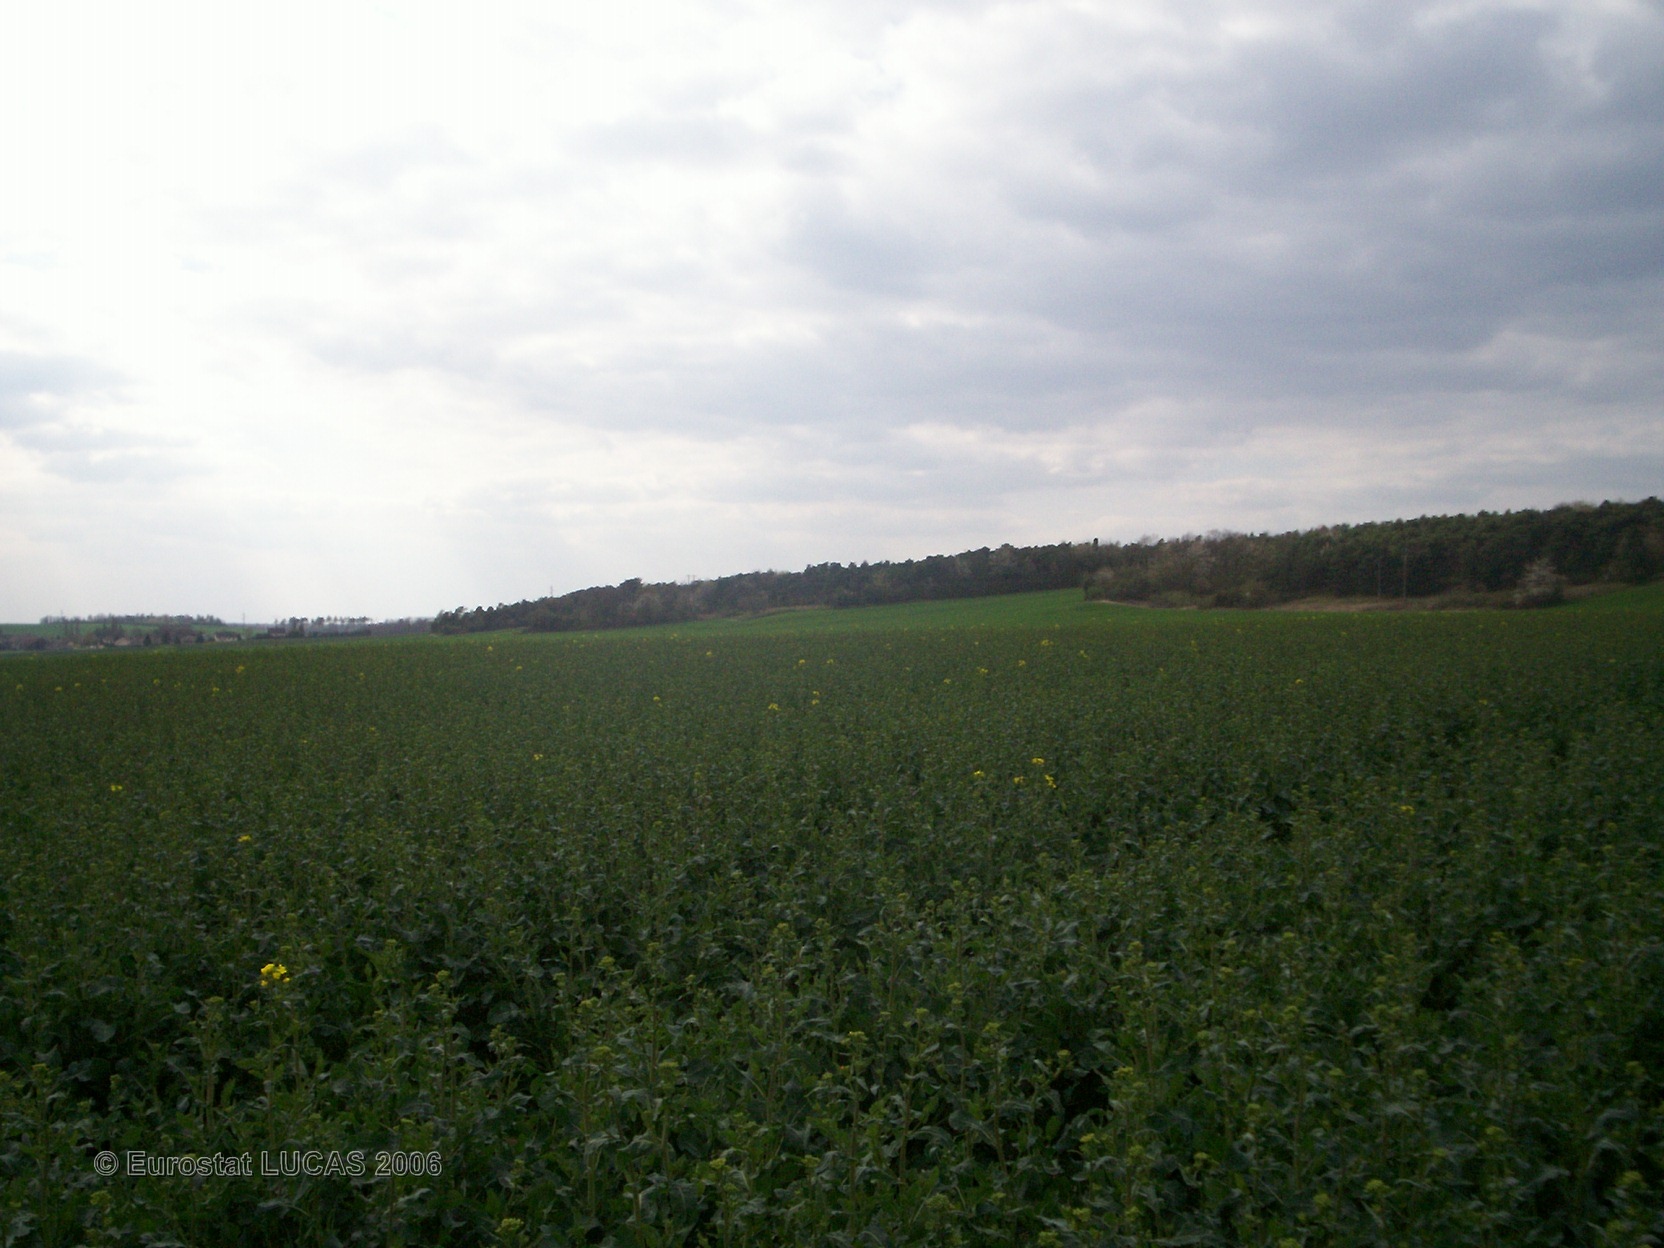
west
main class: Cropland
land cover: Rape and turnip rape
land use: Agriculture (excluding fallow land and kitchen gardens)
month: April
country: FR
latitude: 48.3152
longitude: 2.8310
